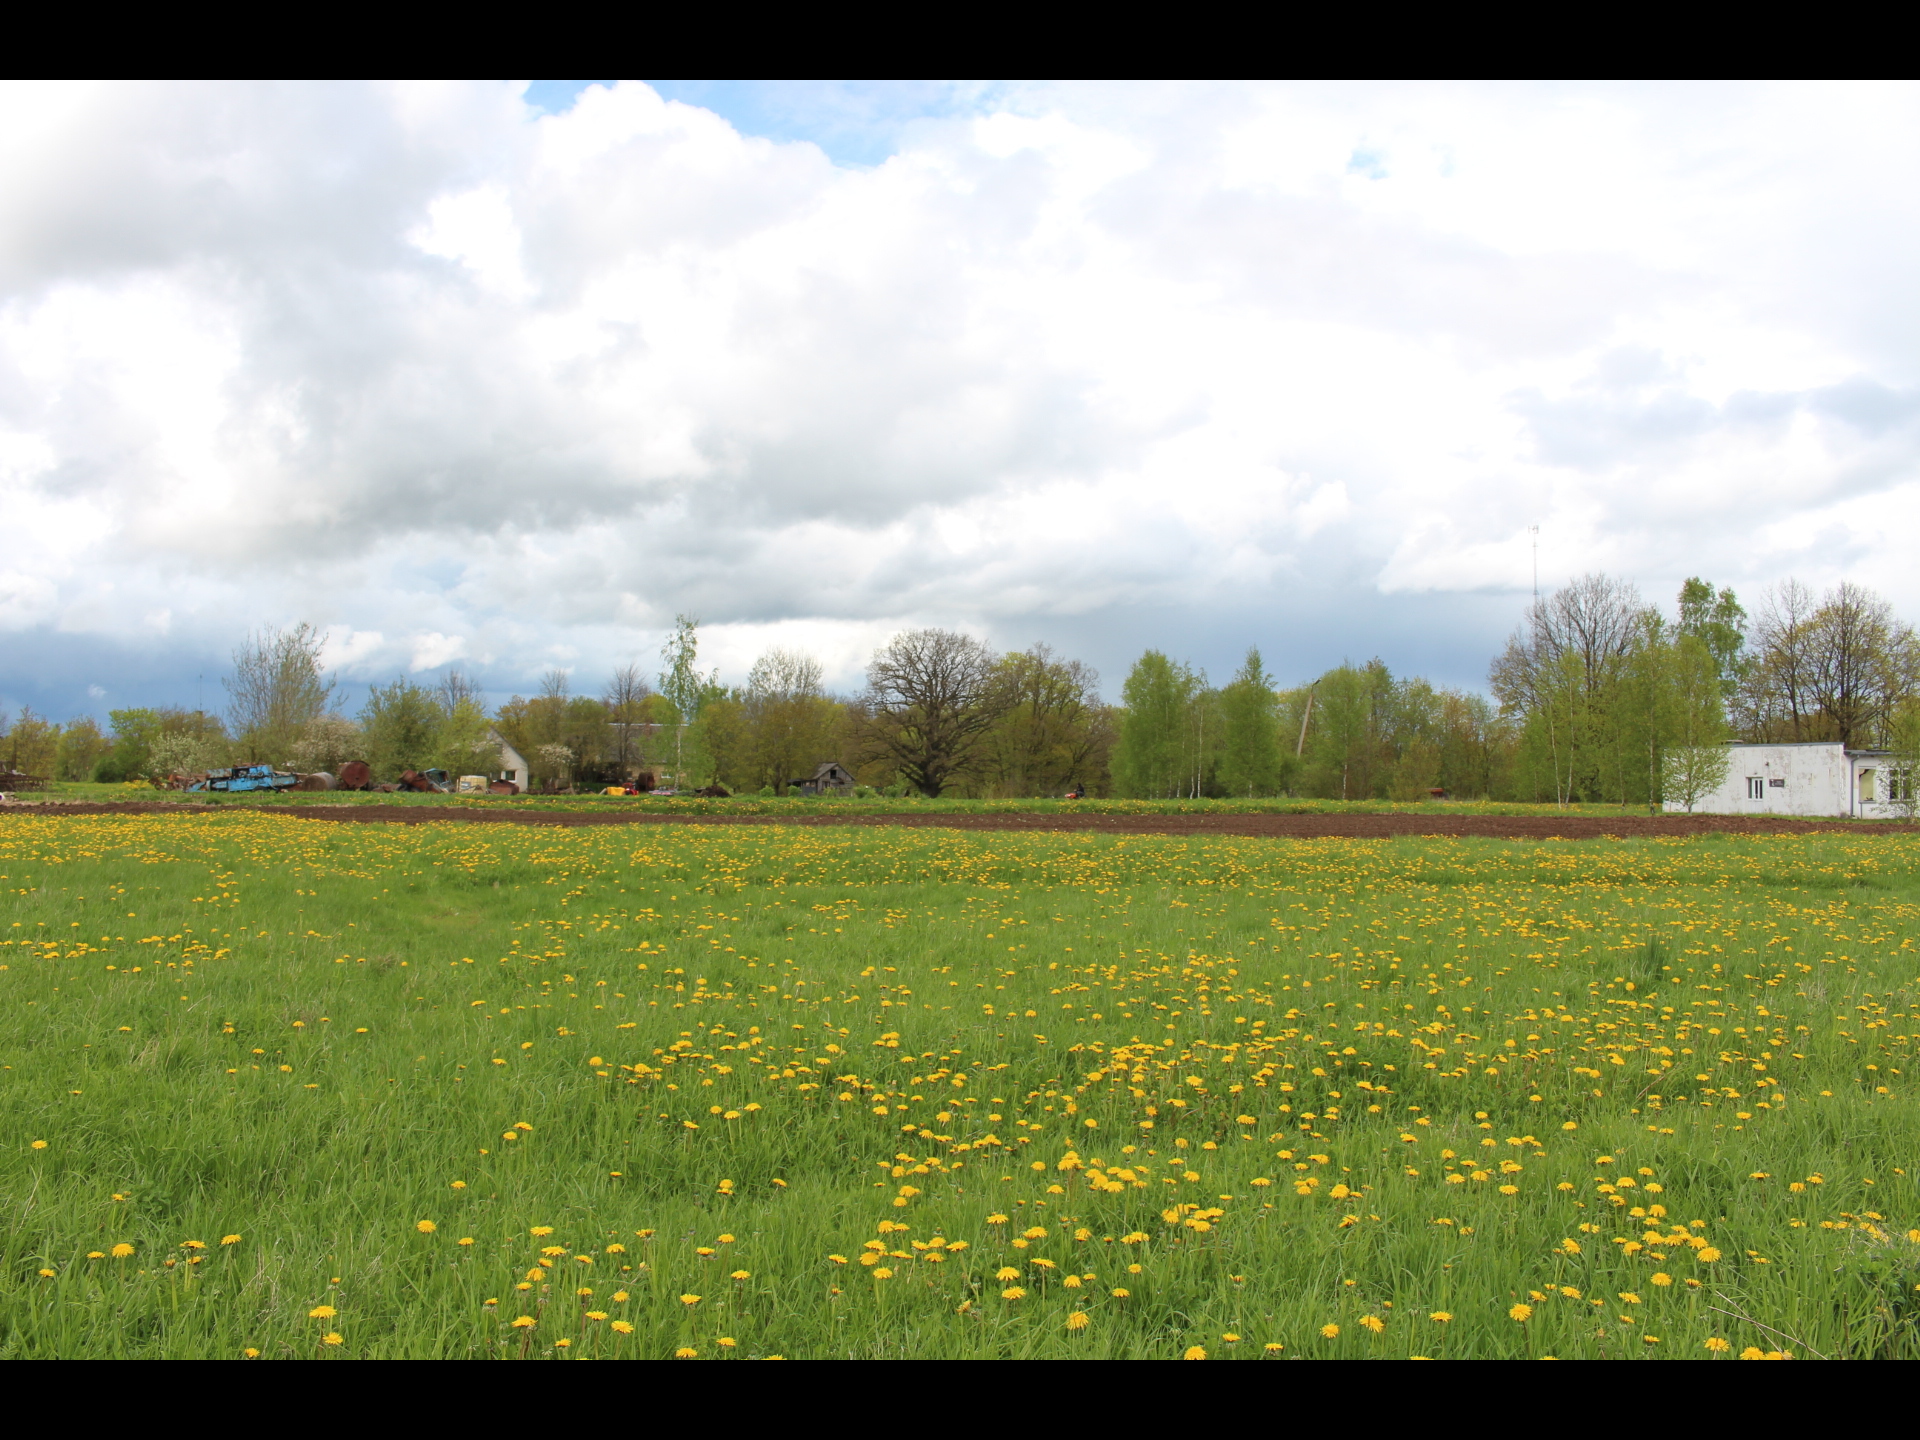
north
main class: Grassland
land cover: Grassland without tree/shrub cover
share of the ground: > 75 %
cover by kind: herbaceous plants 100 %
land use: Agriculture (excluding fallow land and kitchen gardens)
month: May
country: LV
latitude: 56.7966
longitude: 22.8495
